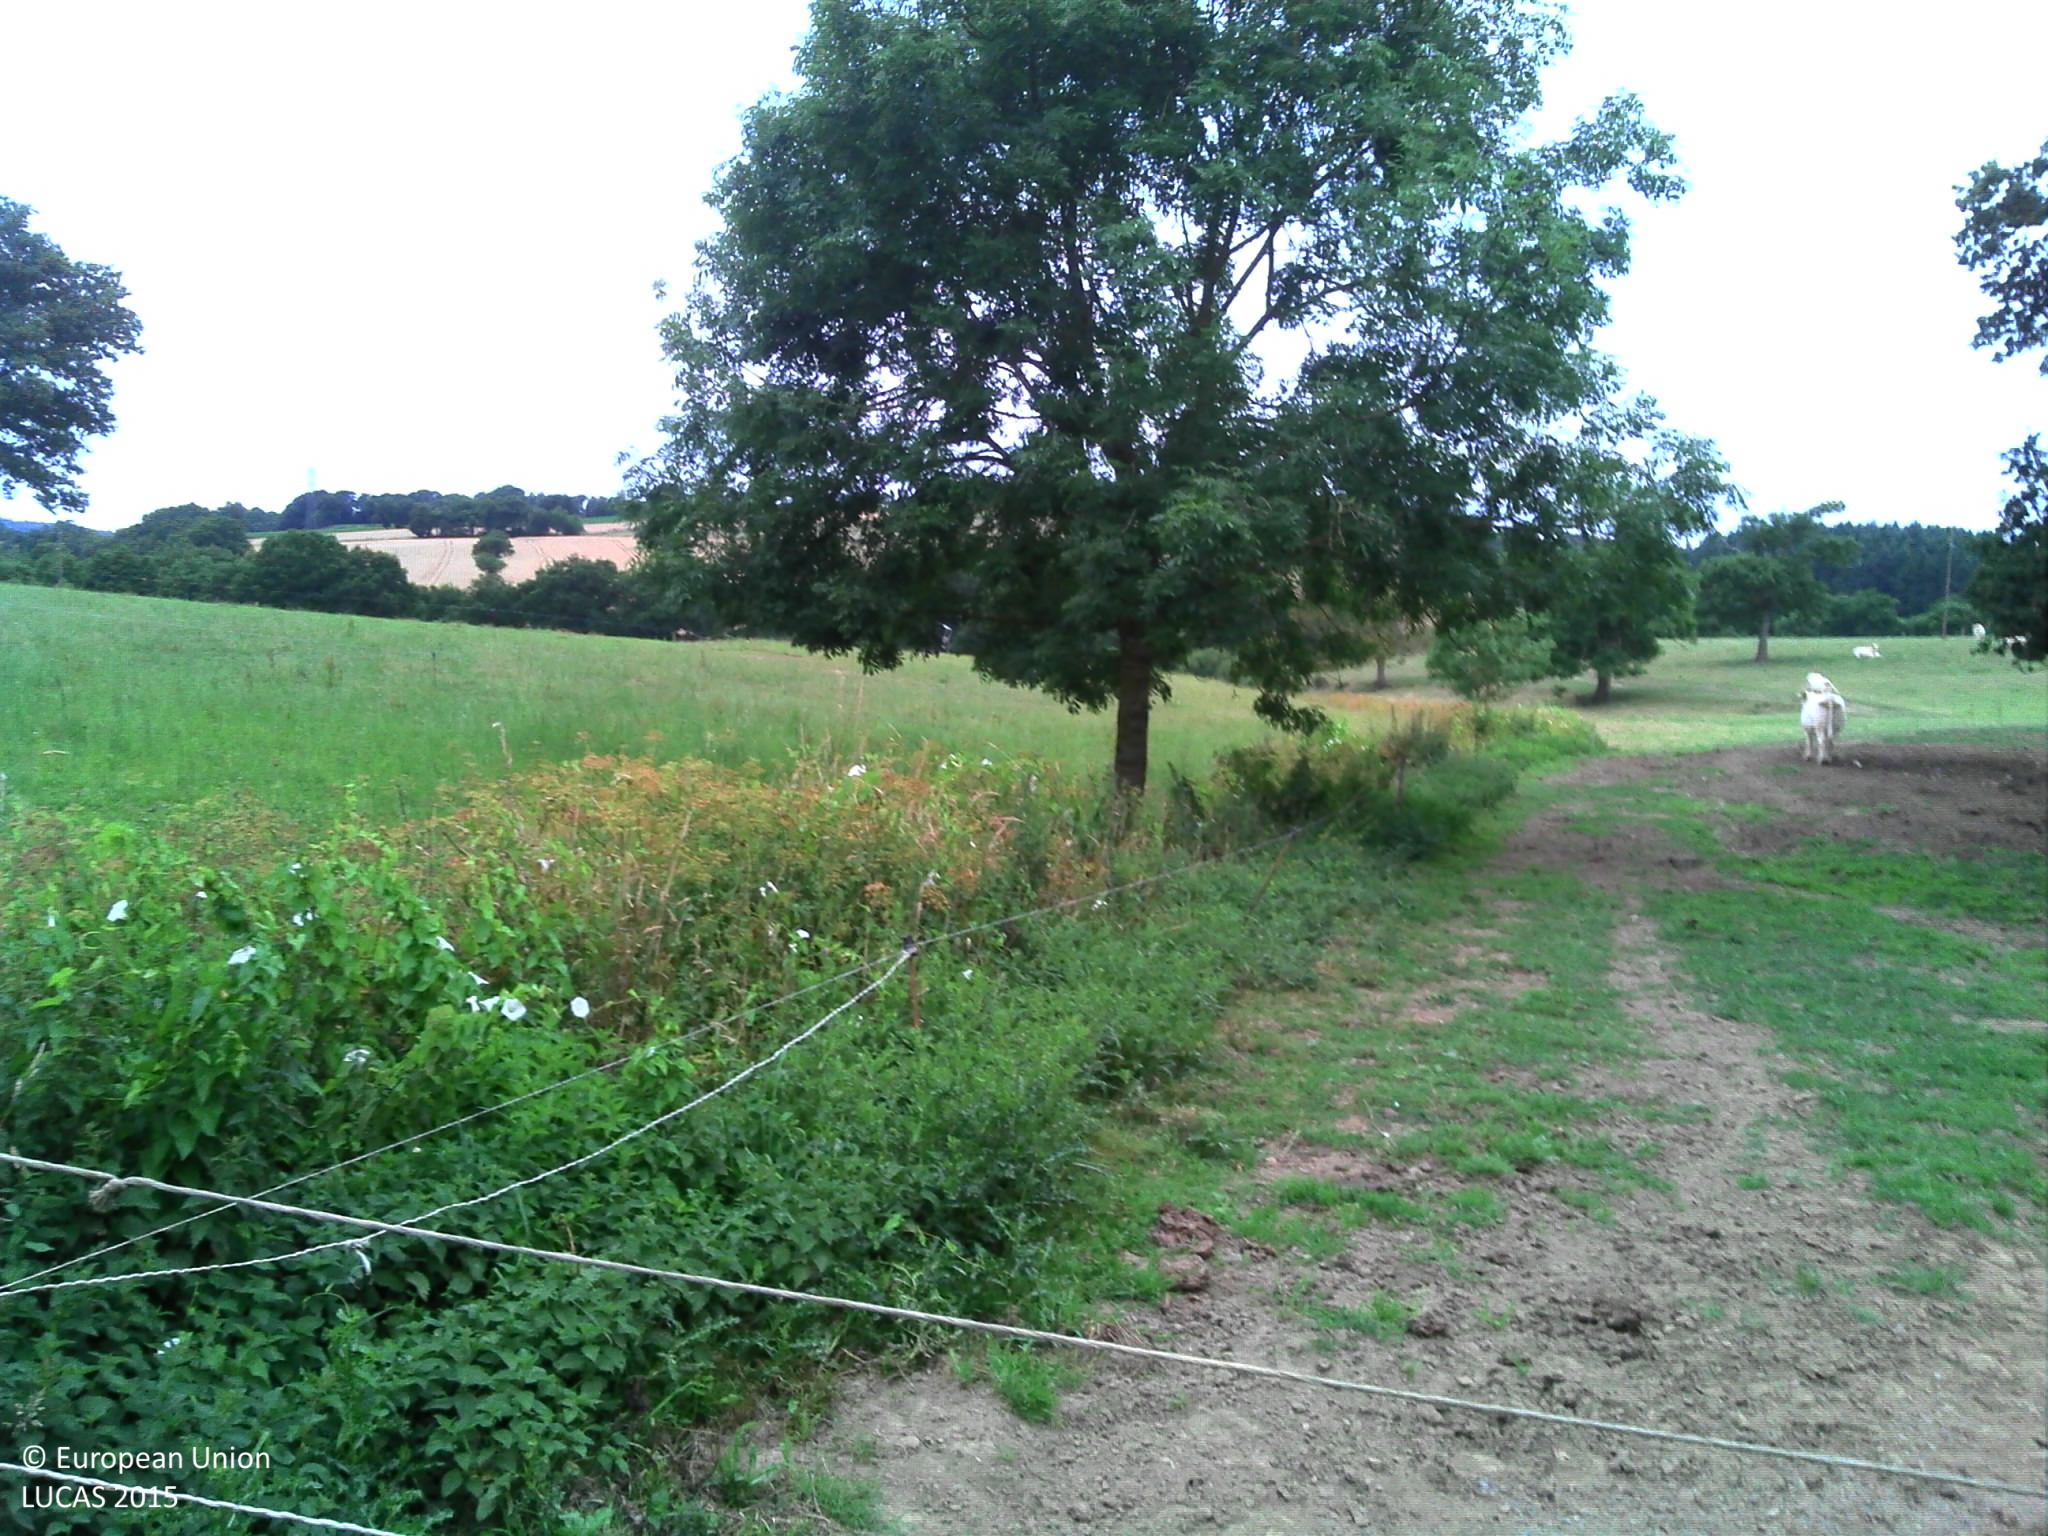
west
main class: Grassland
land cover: Grassland without tree/shrub cover
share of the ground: > 75 %
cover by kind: herbaceous plants 100 %
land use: Agriculture (excluding fallow land and kitchen gardens)
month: July
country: FR
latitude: 47.8773
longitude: -1.6391
